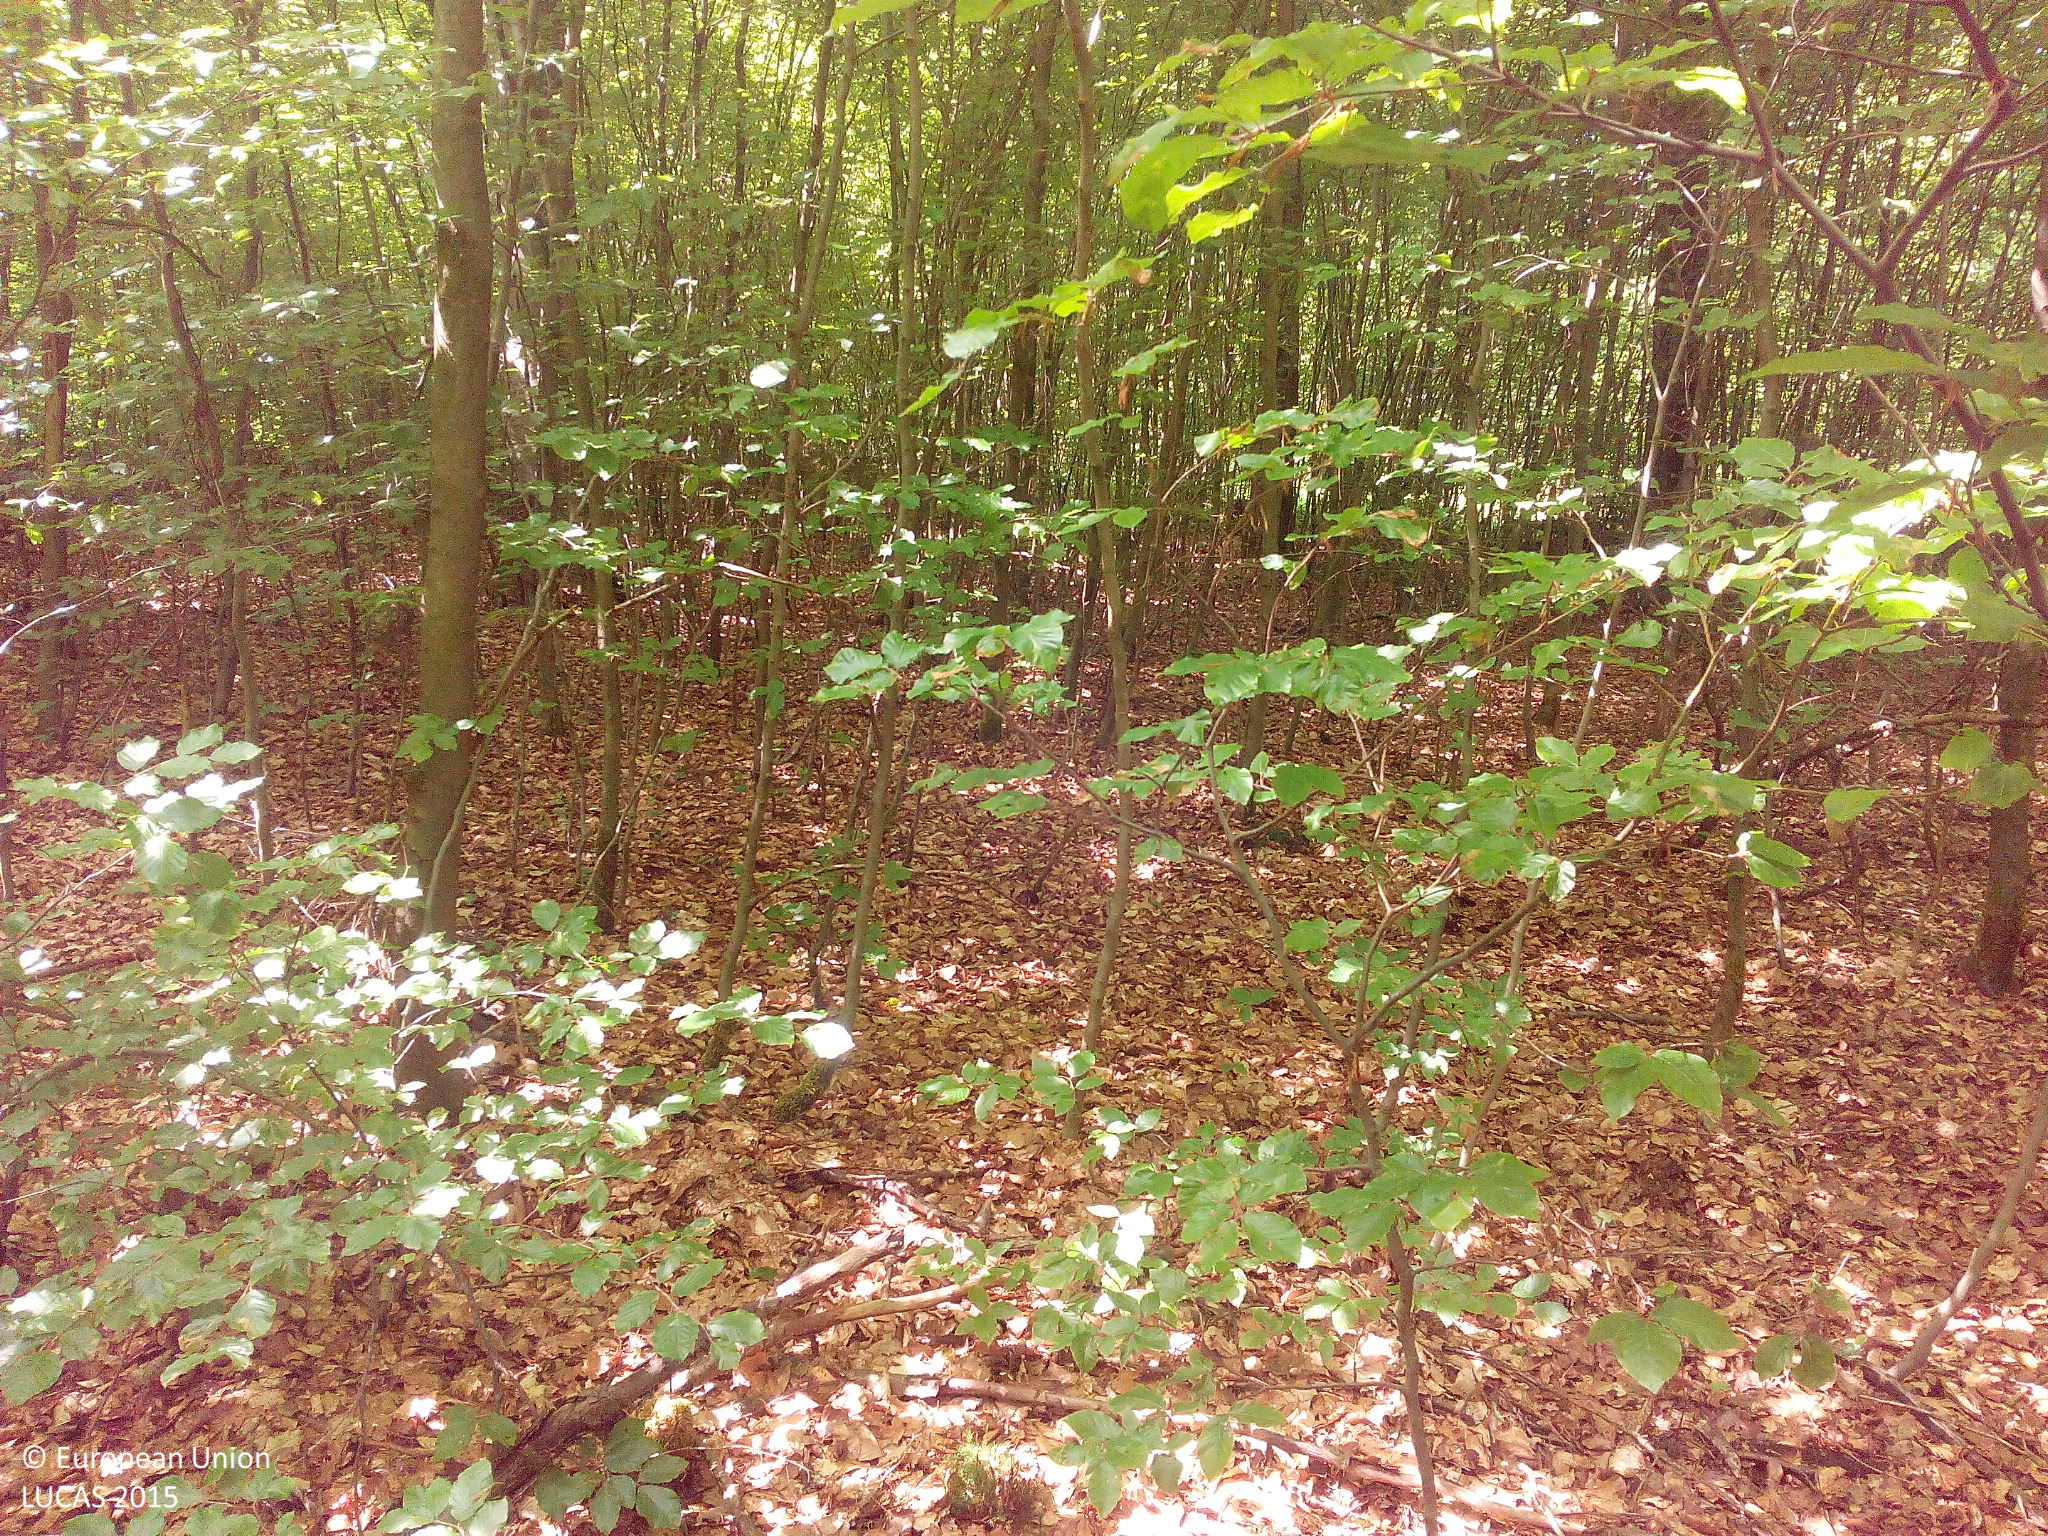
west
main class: Woodland
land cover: Broadleaved woodland
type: beech forest
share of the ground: > 75 %
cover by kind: broadleaved forest trees 95 %, unconsolidated bare surface 5 %
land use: Forestry
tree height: > 5 m
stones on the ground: < 10 %
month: May
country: DE
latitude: 51.2265
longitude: 9.6421
